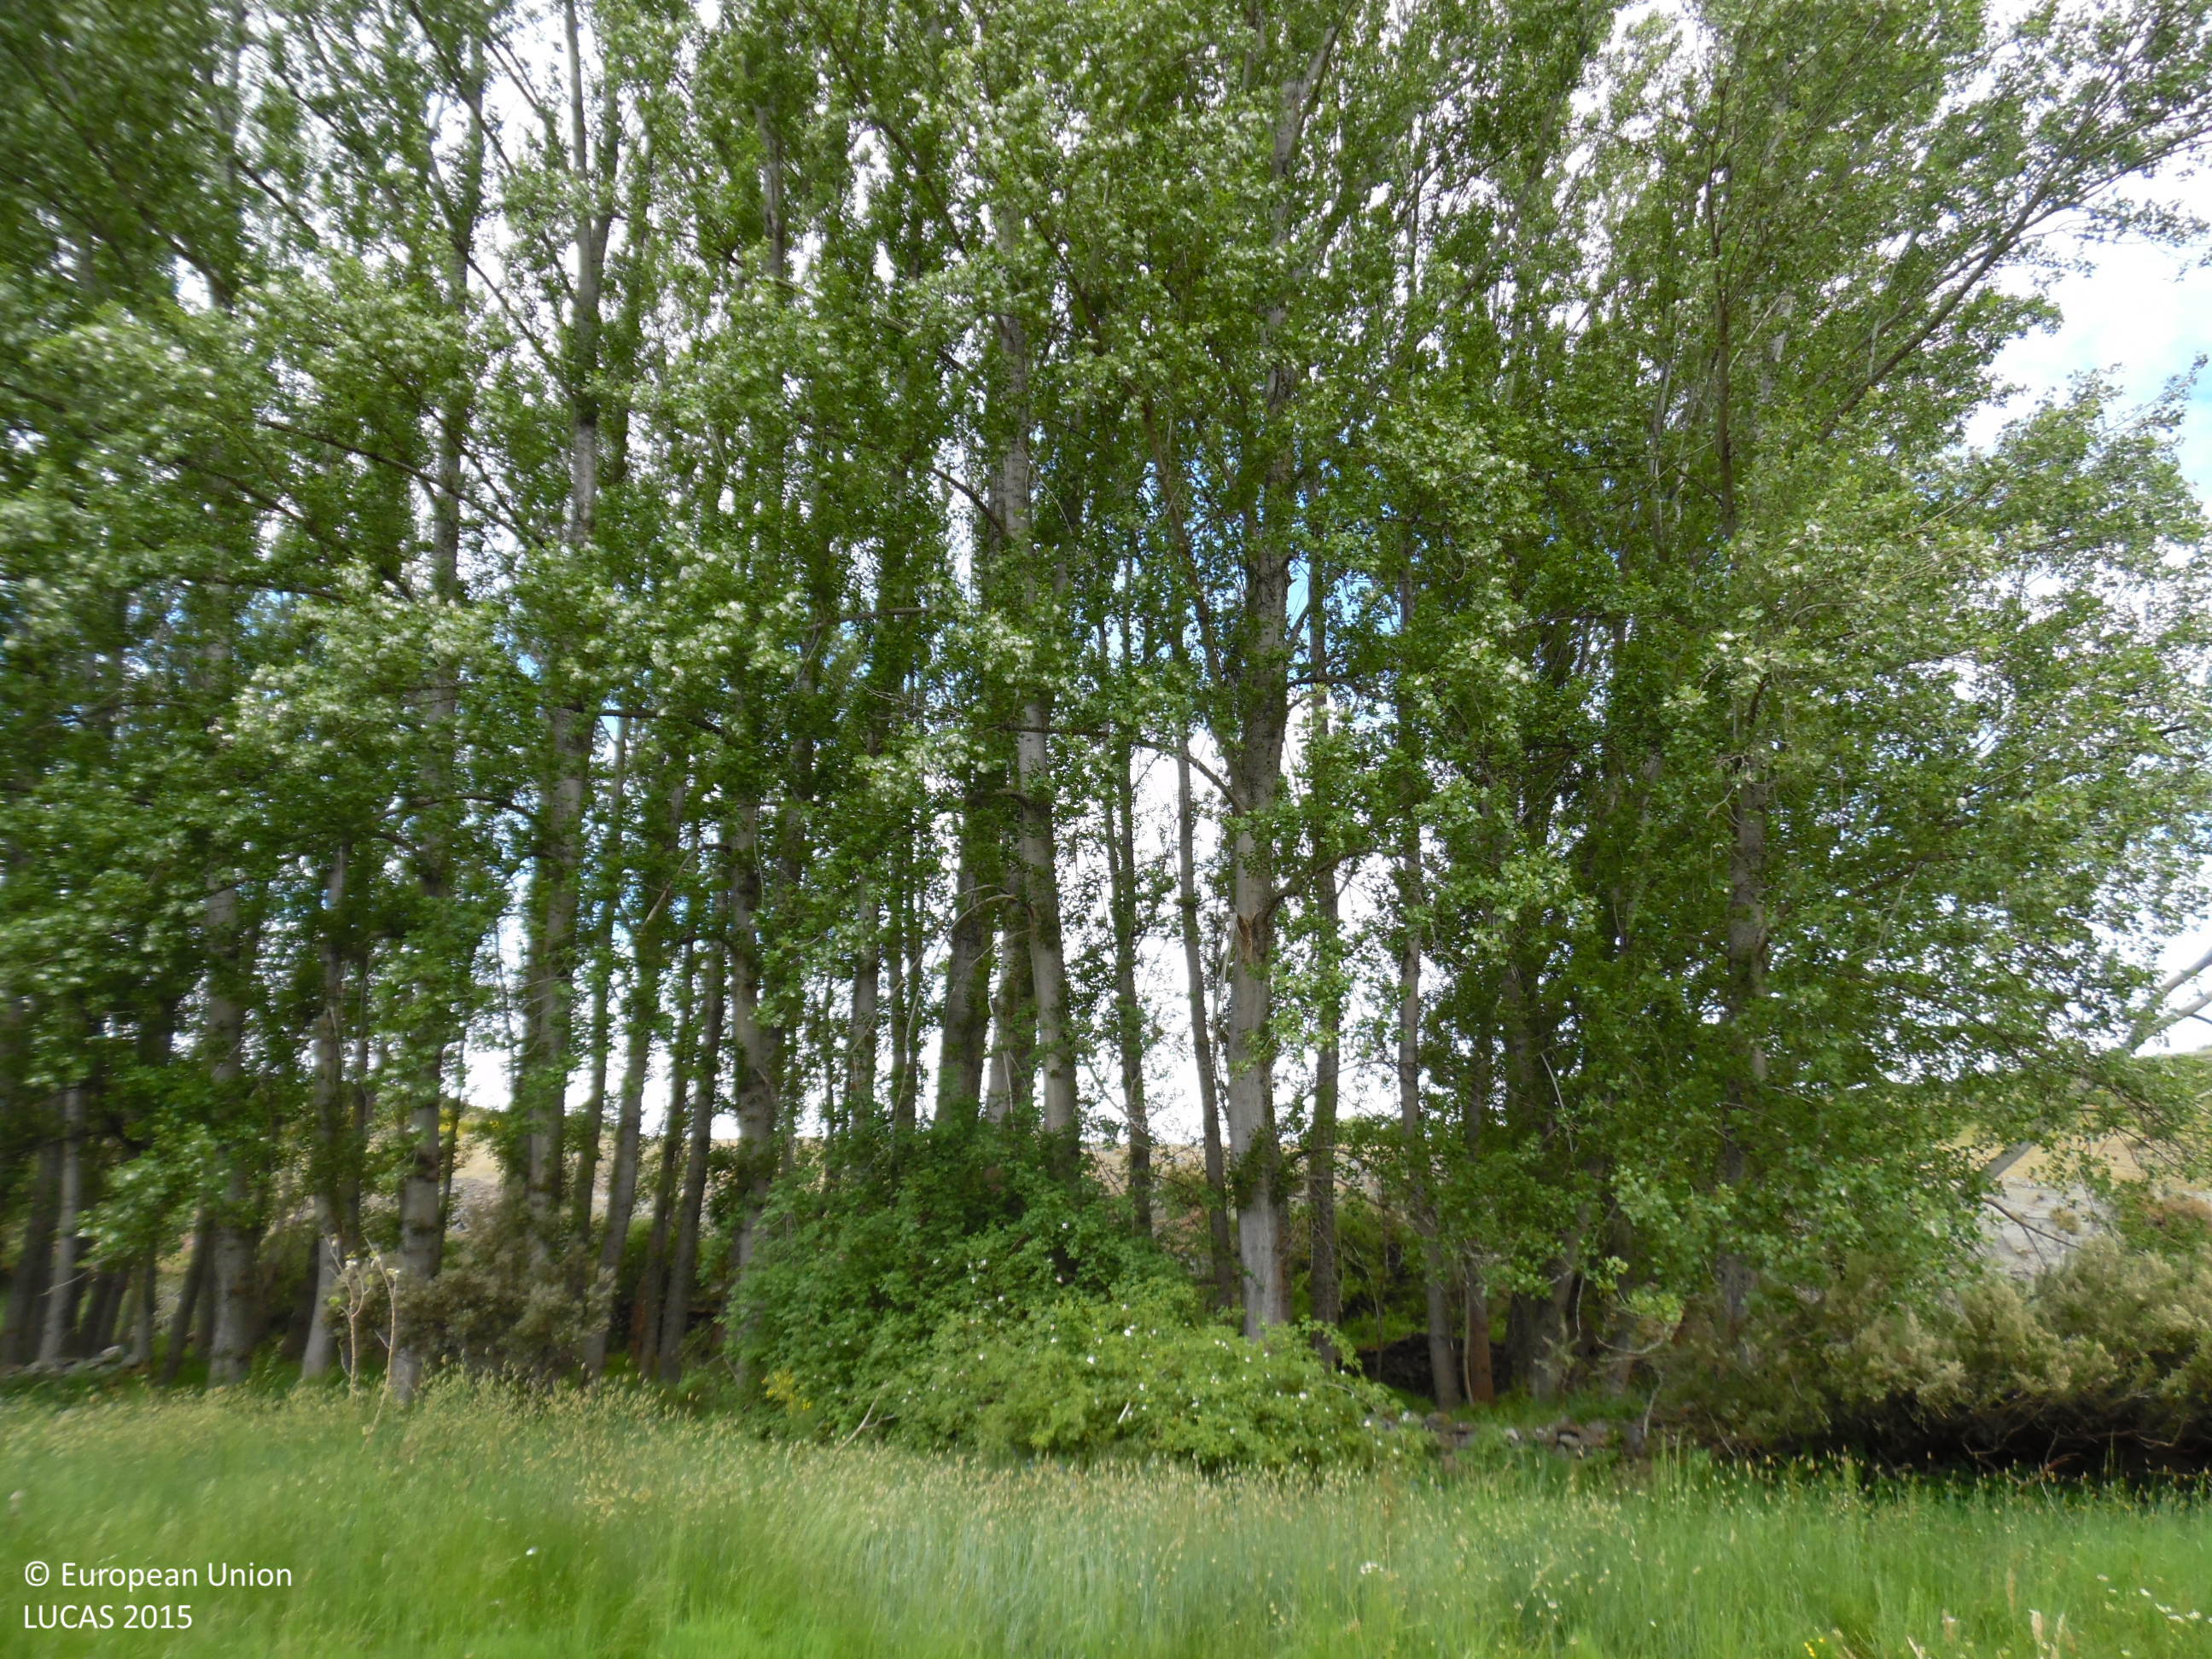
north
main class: Shrubland
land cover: Shrubland with sparse tree cover
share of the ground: > 75 %
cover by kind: shrubs 95 %, broadleaved forest trees 5 %
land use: Semi-natural and natural areas not in use
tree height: > 5 m
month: May
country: ES
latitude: 42.4556
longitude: -6.3459
